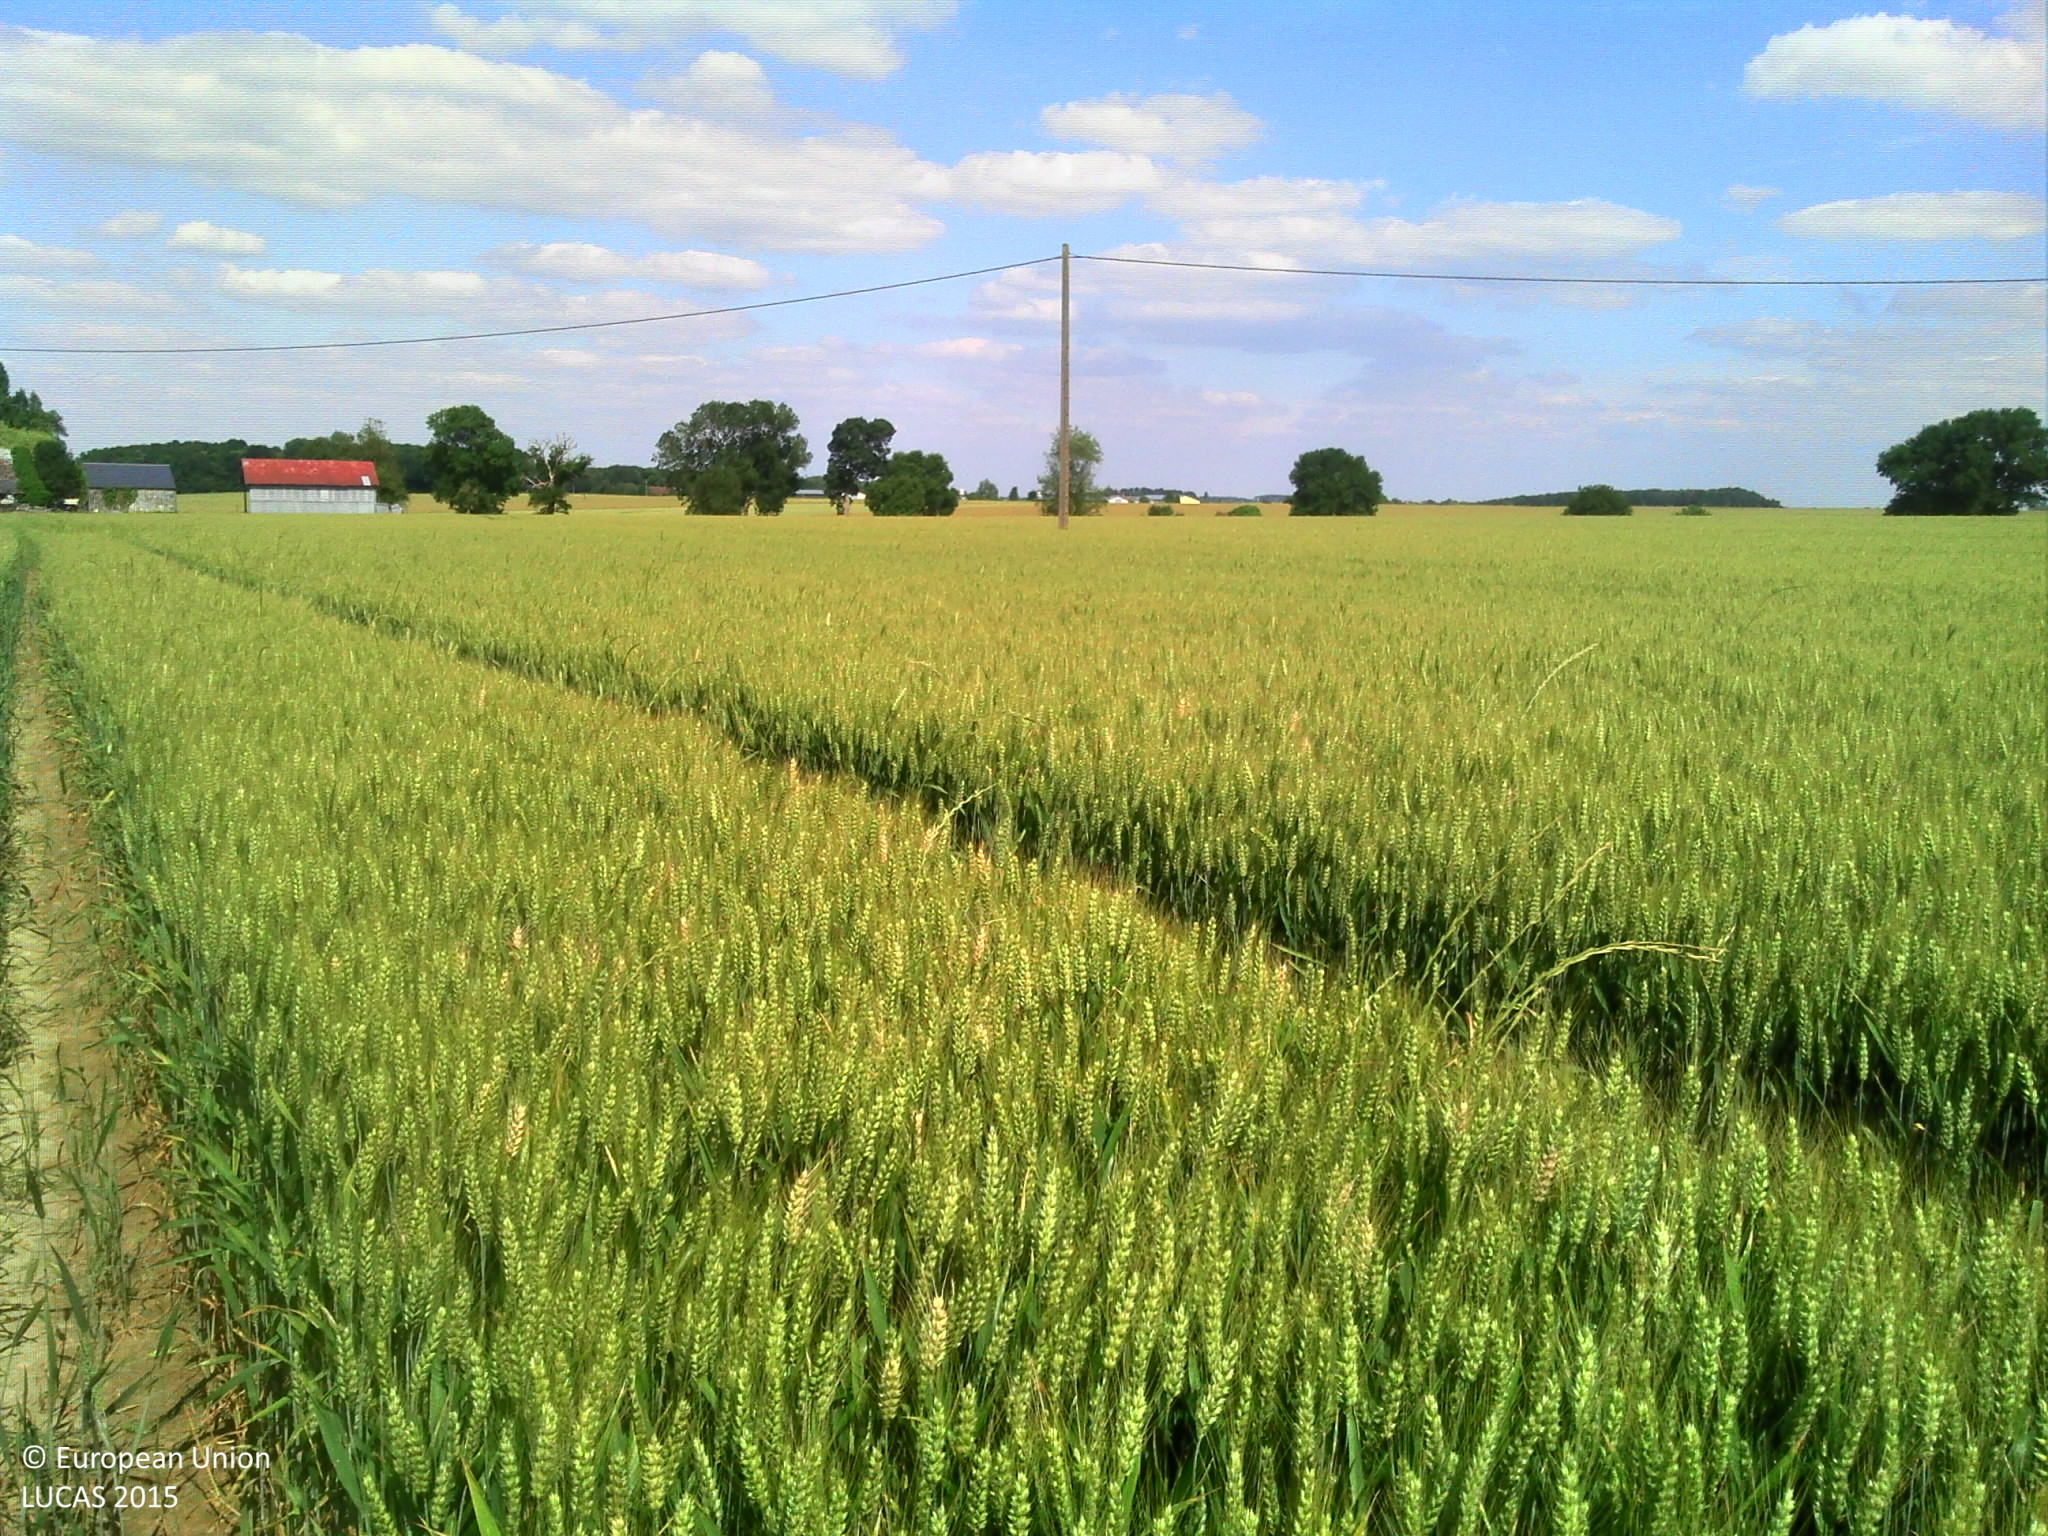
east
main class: Cropland
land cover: Durum wheat
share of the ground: > 75 %
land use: Agriculture (excluding fallow land and kitchen gardens)
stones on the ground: < 10 %
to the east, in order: Durum wheat; Electric lines; Durum wheat; Fences; Grassland with sparse tree/shrub cover
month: June
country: FR
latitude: 47.5567
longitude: 0.4761
